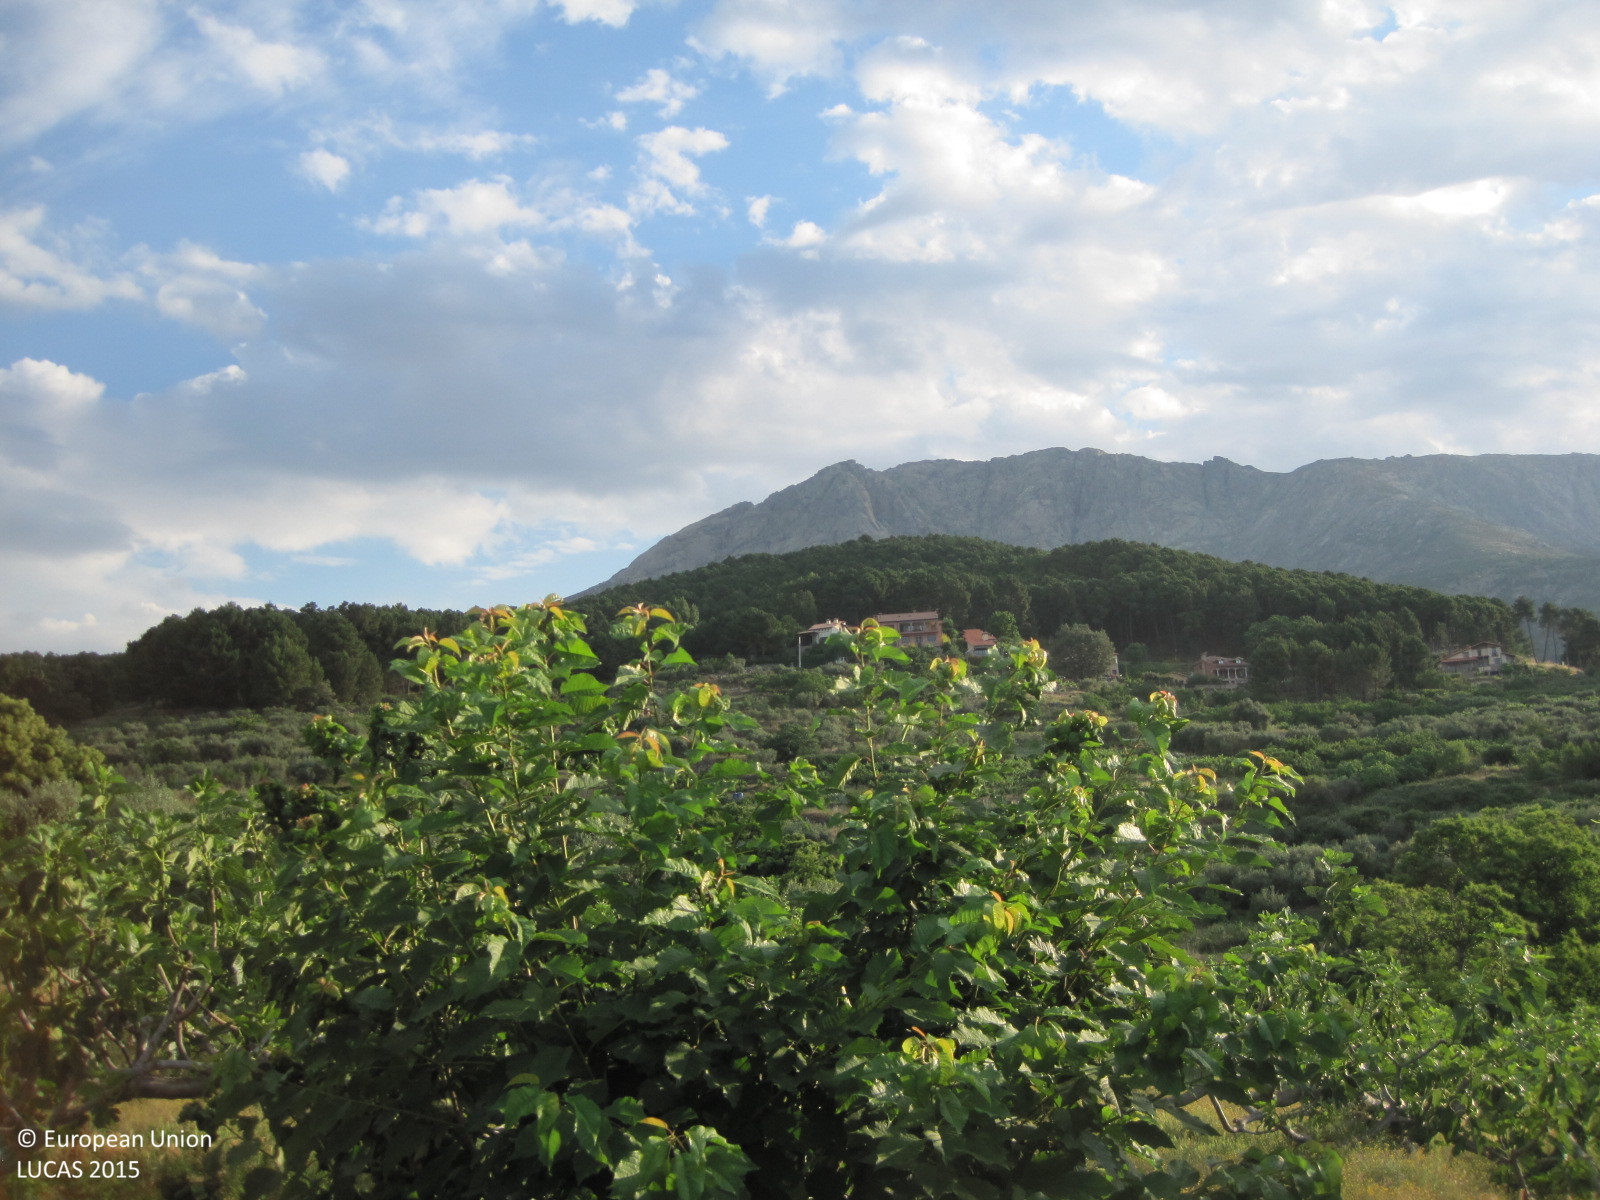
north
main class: Cropland
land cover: Vineyards
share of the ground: 25 - 50 %
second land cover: Nuts trees
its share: 25 - 50 %
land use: Agriculture (excluding fallow land and kitchen gardens)
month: June
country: ES
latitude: 40.2814
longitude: -5.0044
